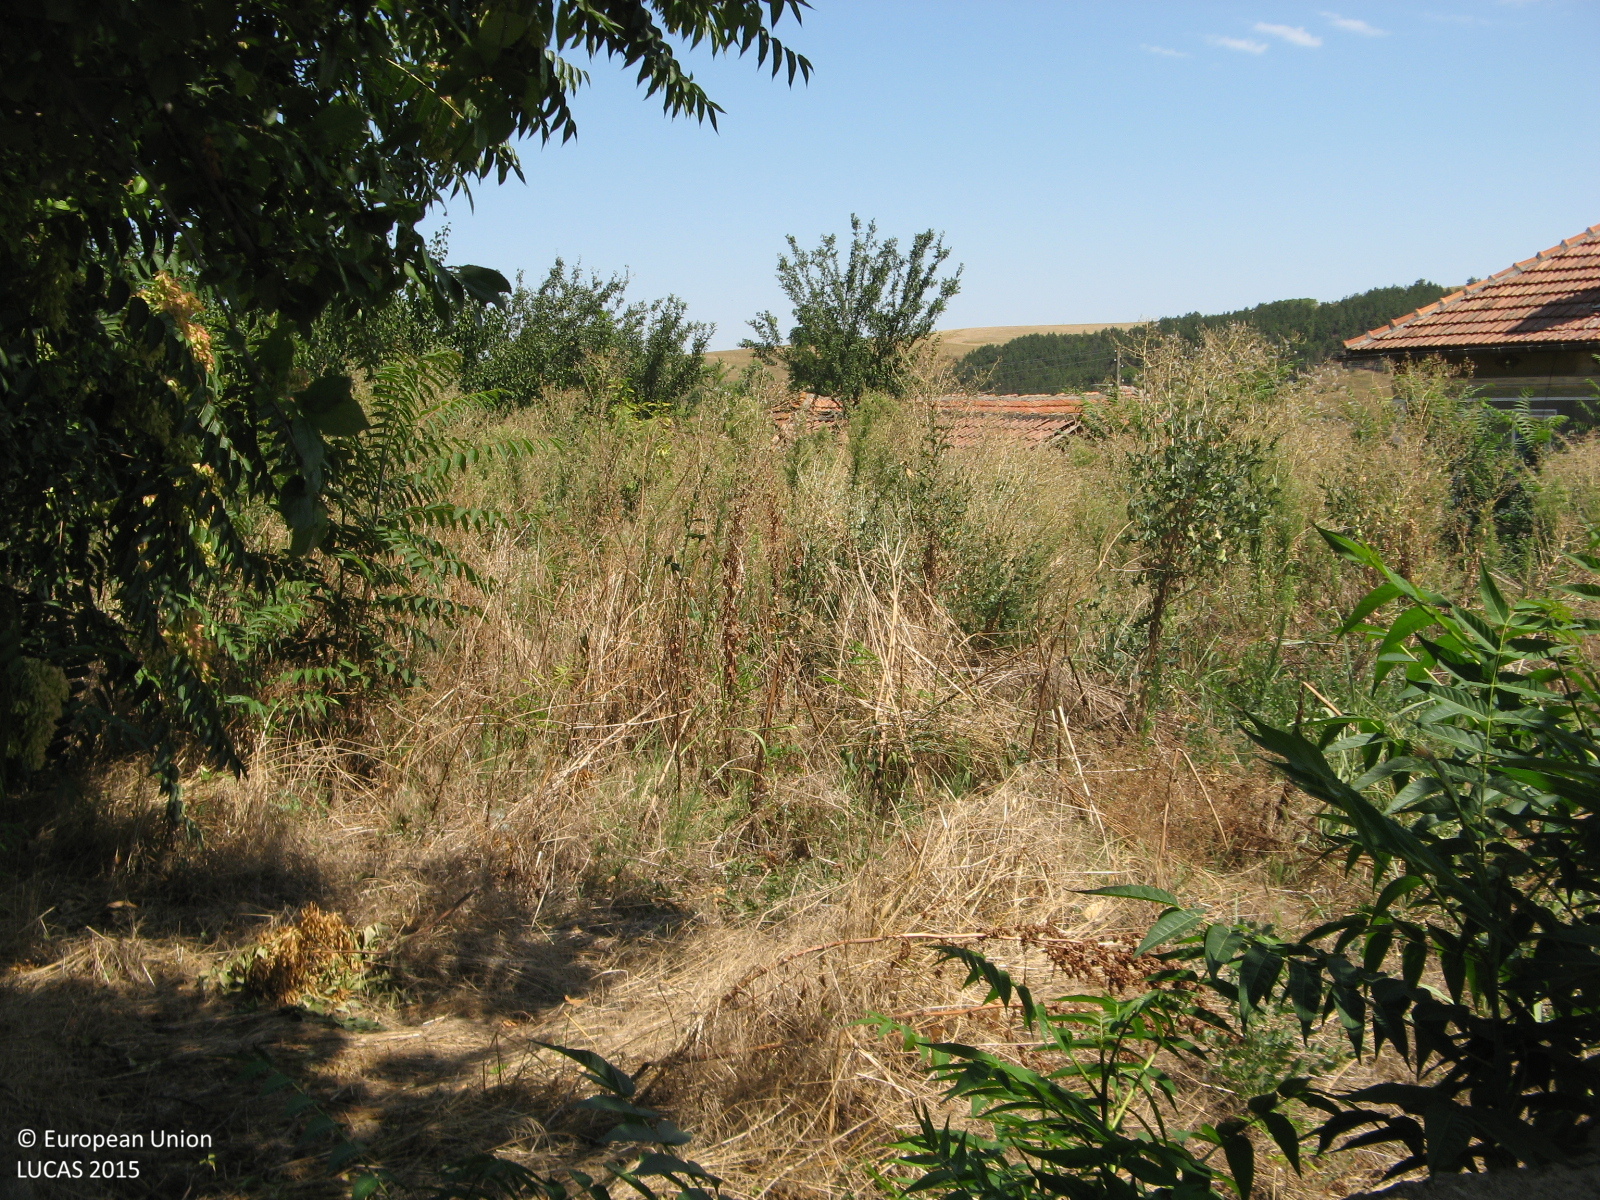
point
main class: Grassland
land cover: Spontaneously vegetated surfaces
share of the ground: > 75 %
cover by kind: herbaceous plants 95 %, shrubs 5 %
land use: Abandoned areas
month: August
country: BG
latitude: 43.5112
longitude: 25.3553
